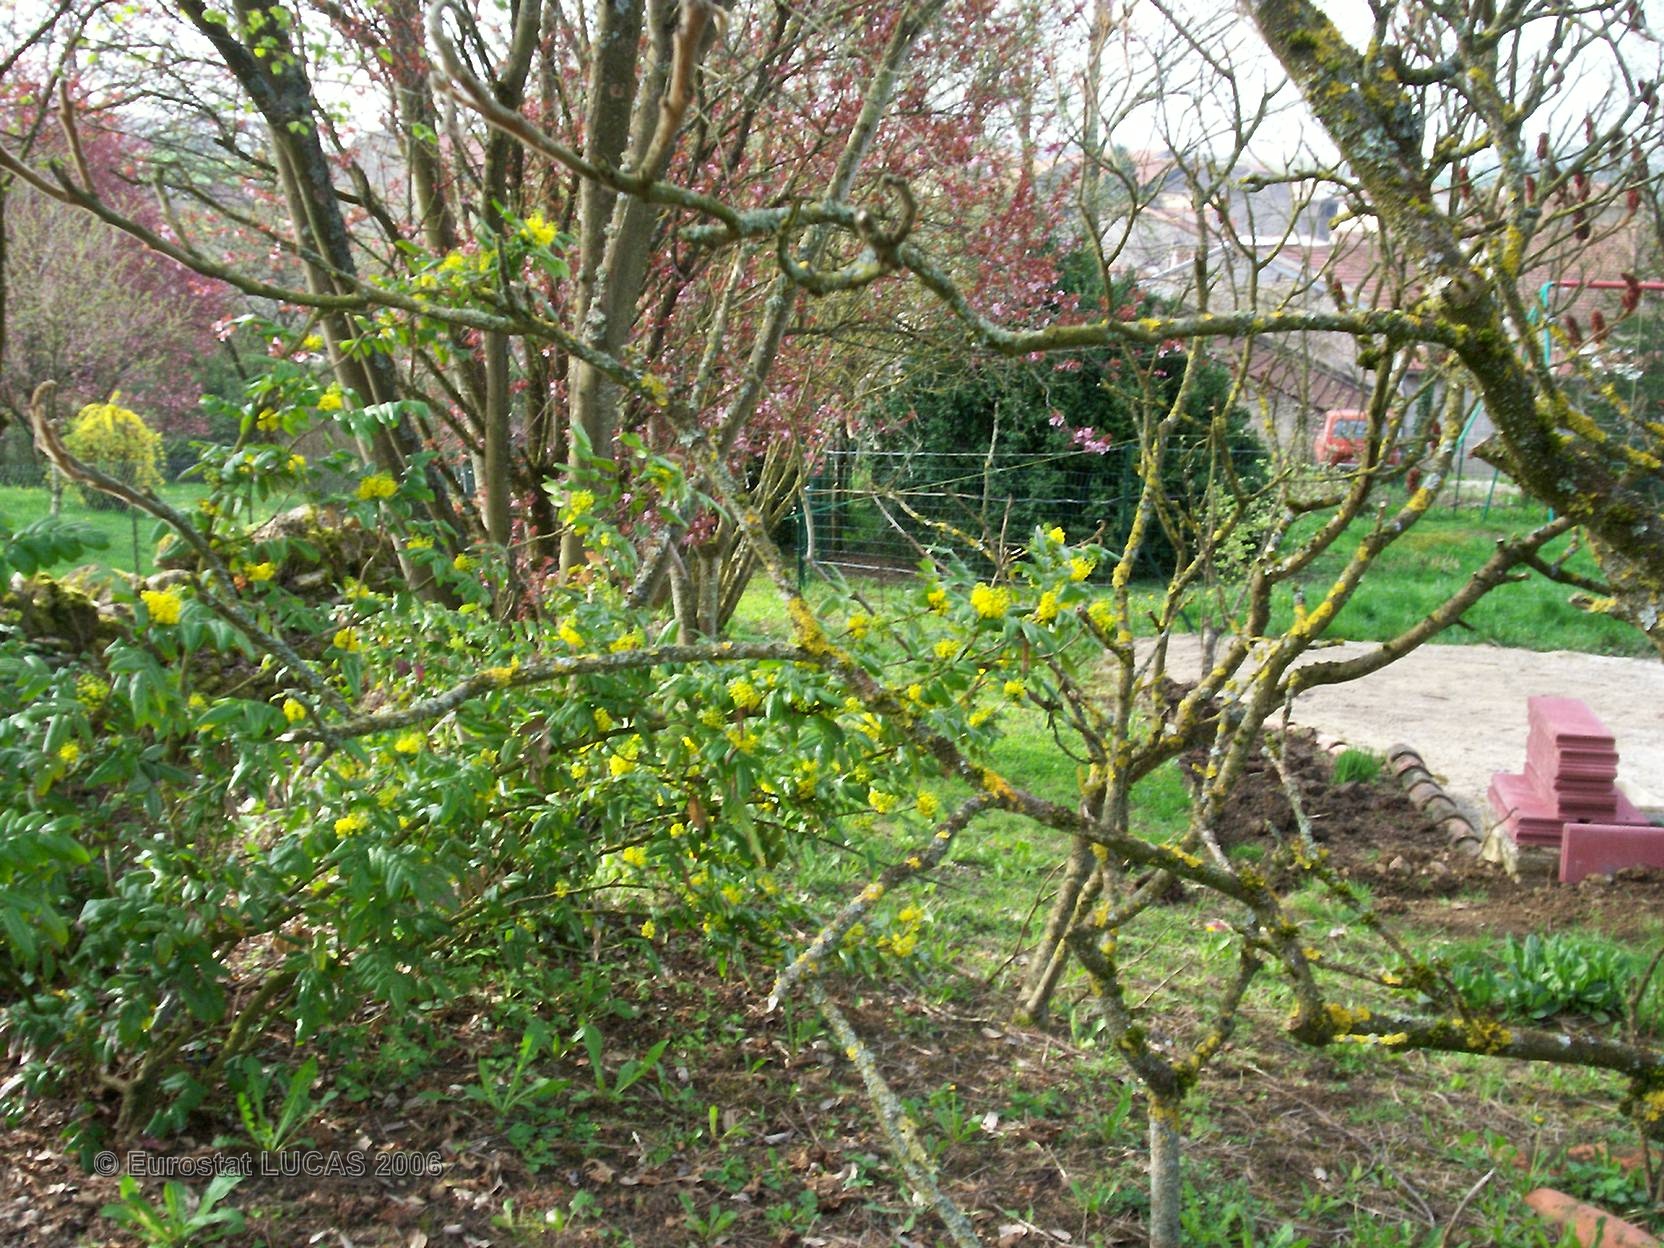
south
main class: Grassland
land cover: Grassland with sparse tree/shrub cover
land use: Residential
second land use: Kitchen garden
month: April
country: FR
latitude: 48.1673
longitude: 5.9531
